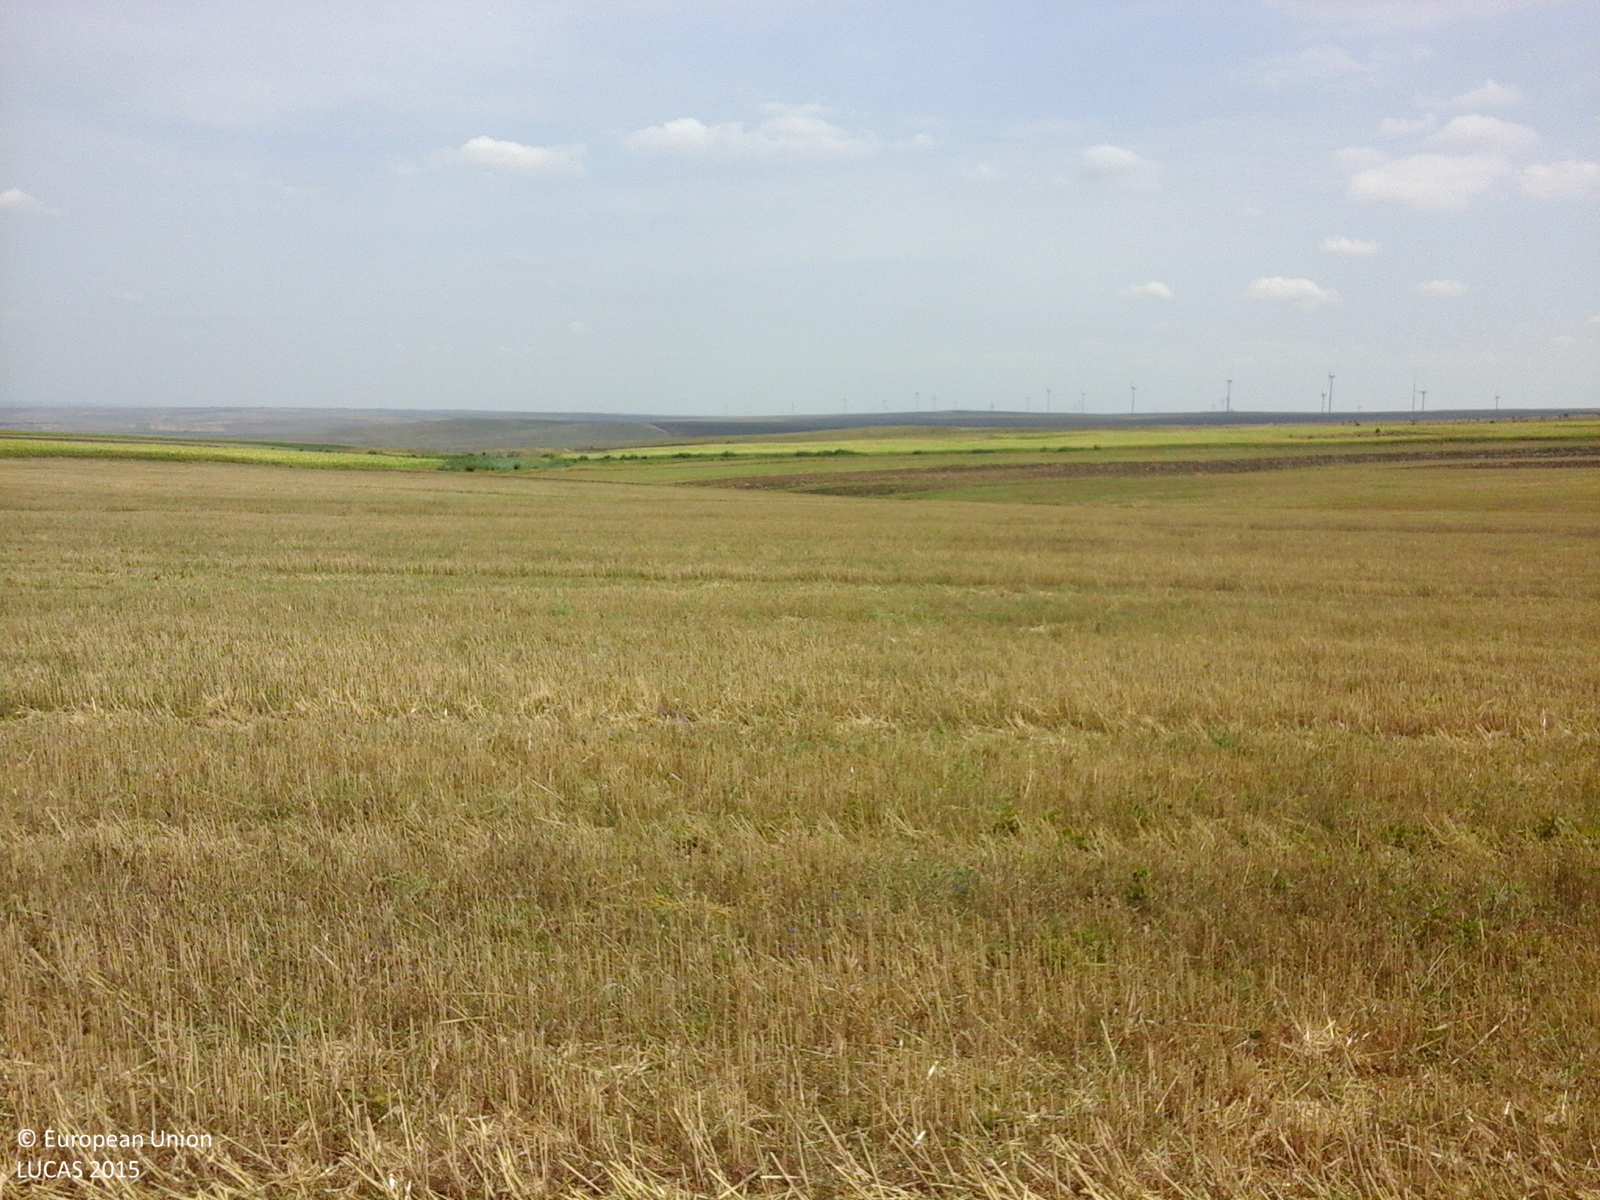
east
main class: Cropland
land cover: Common wheat
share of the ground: > 75 %
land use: Agriculture (excluding fallow land and kitchen gardens)
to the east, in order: Common wheat; Other bare soil; Common wheat; Other bare soil
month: August
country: RO
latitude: 44.6718
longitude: 28.5564
